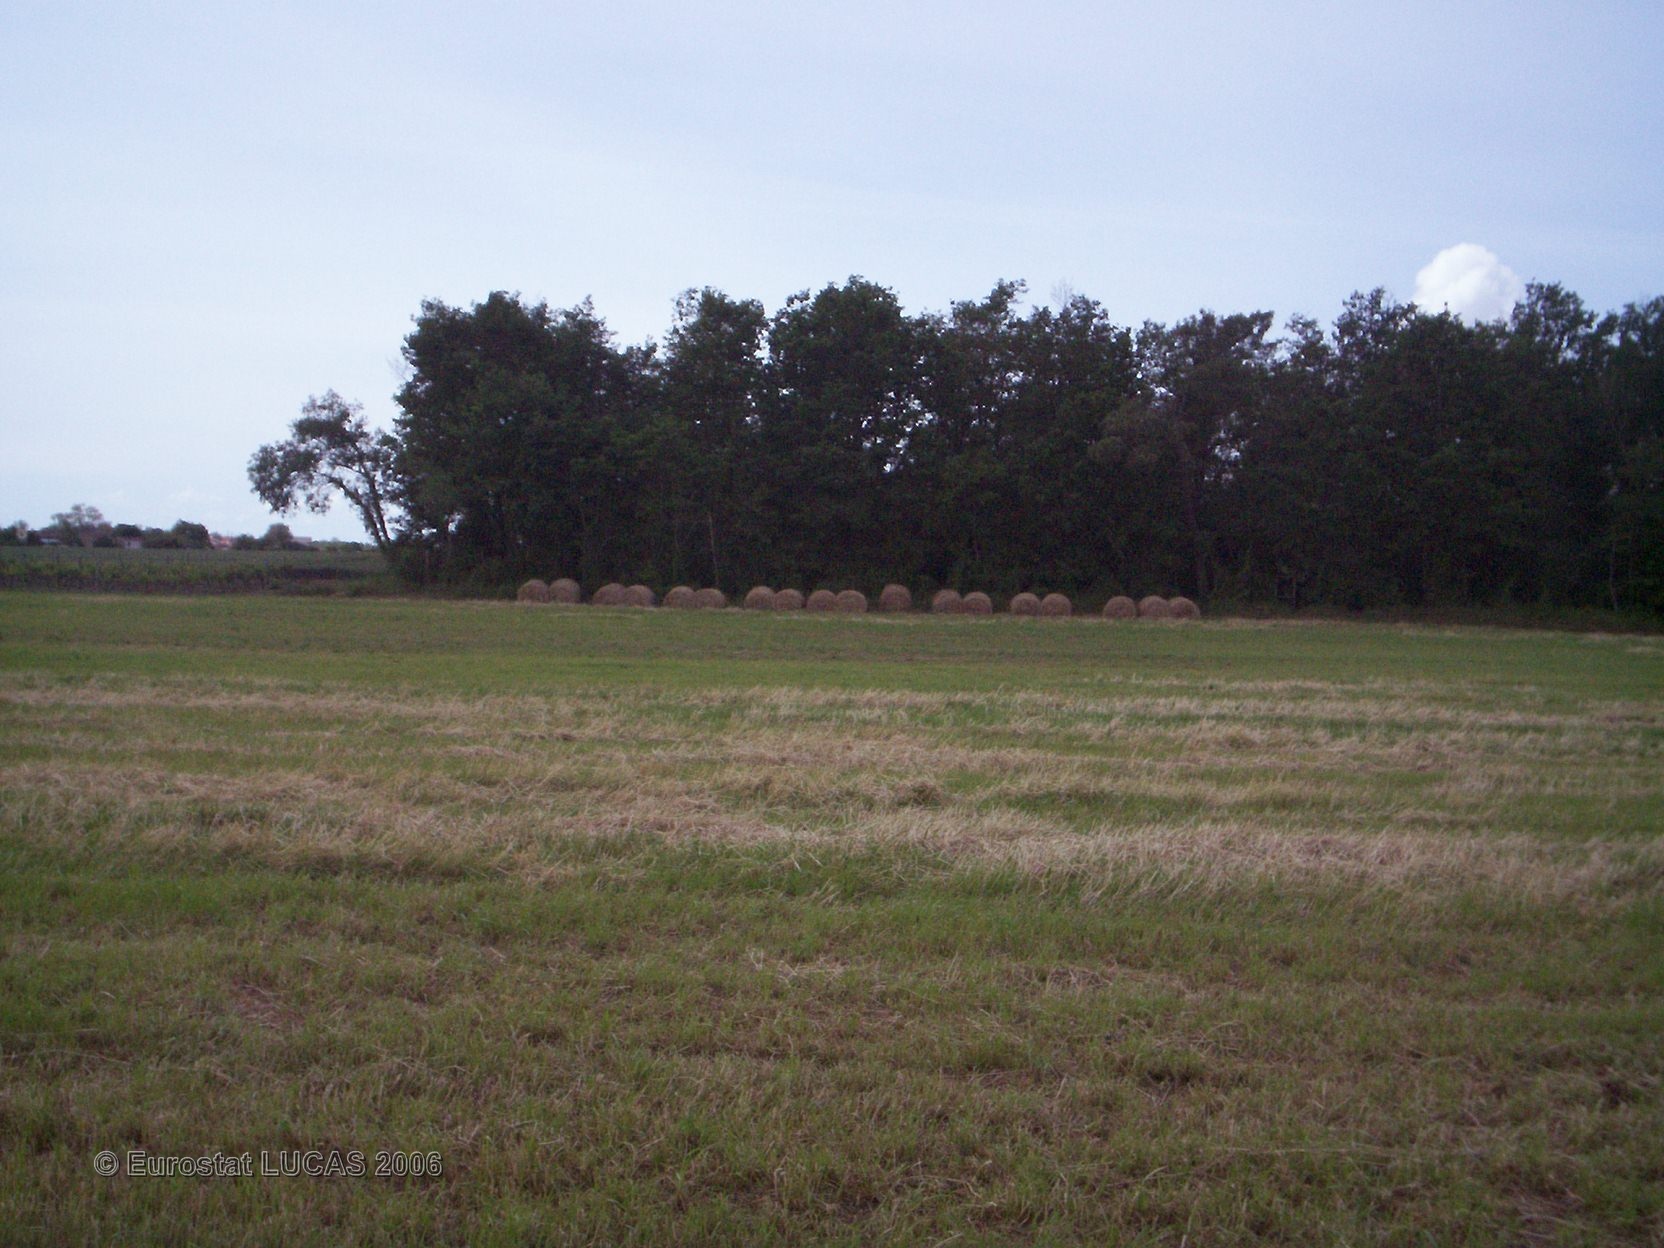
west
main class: Grassland
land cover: Grassland without tree/shrub cover
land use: Agriculture (excluding fallow land and kitchen gardens)
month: May
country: FR
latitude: 45.6251
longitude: -0.7602
